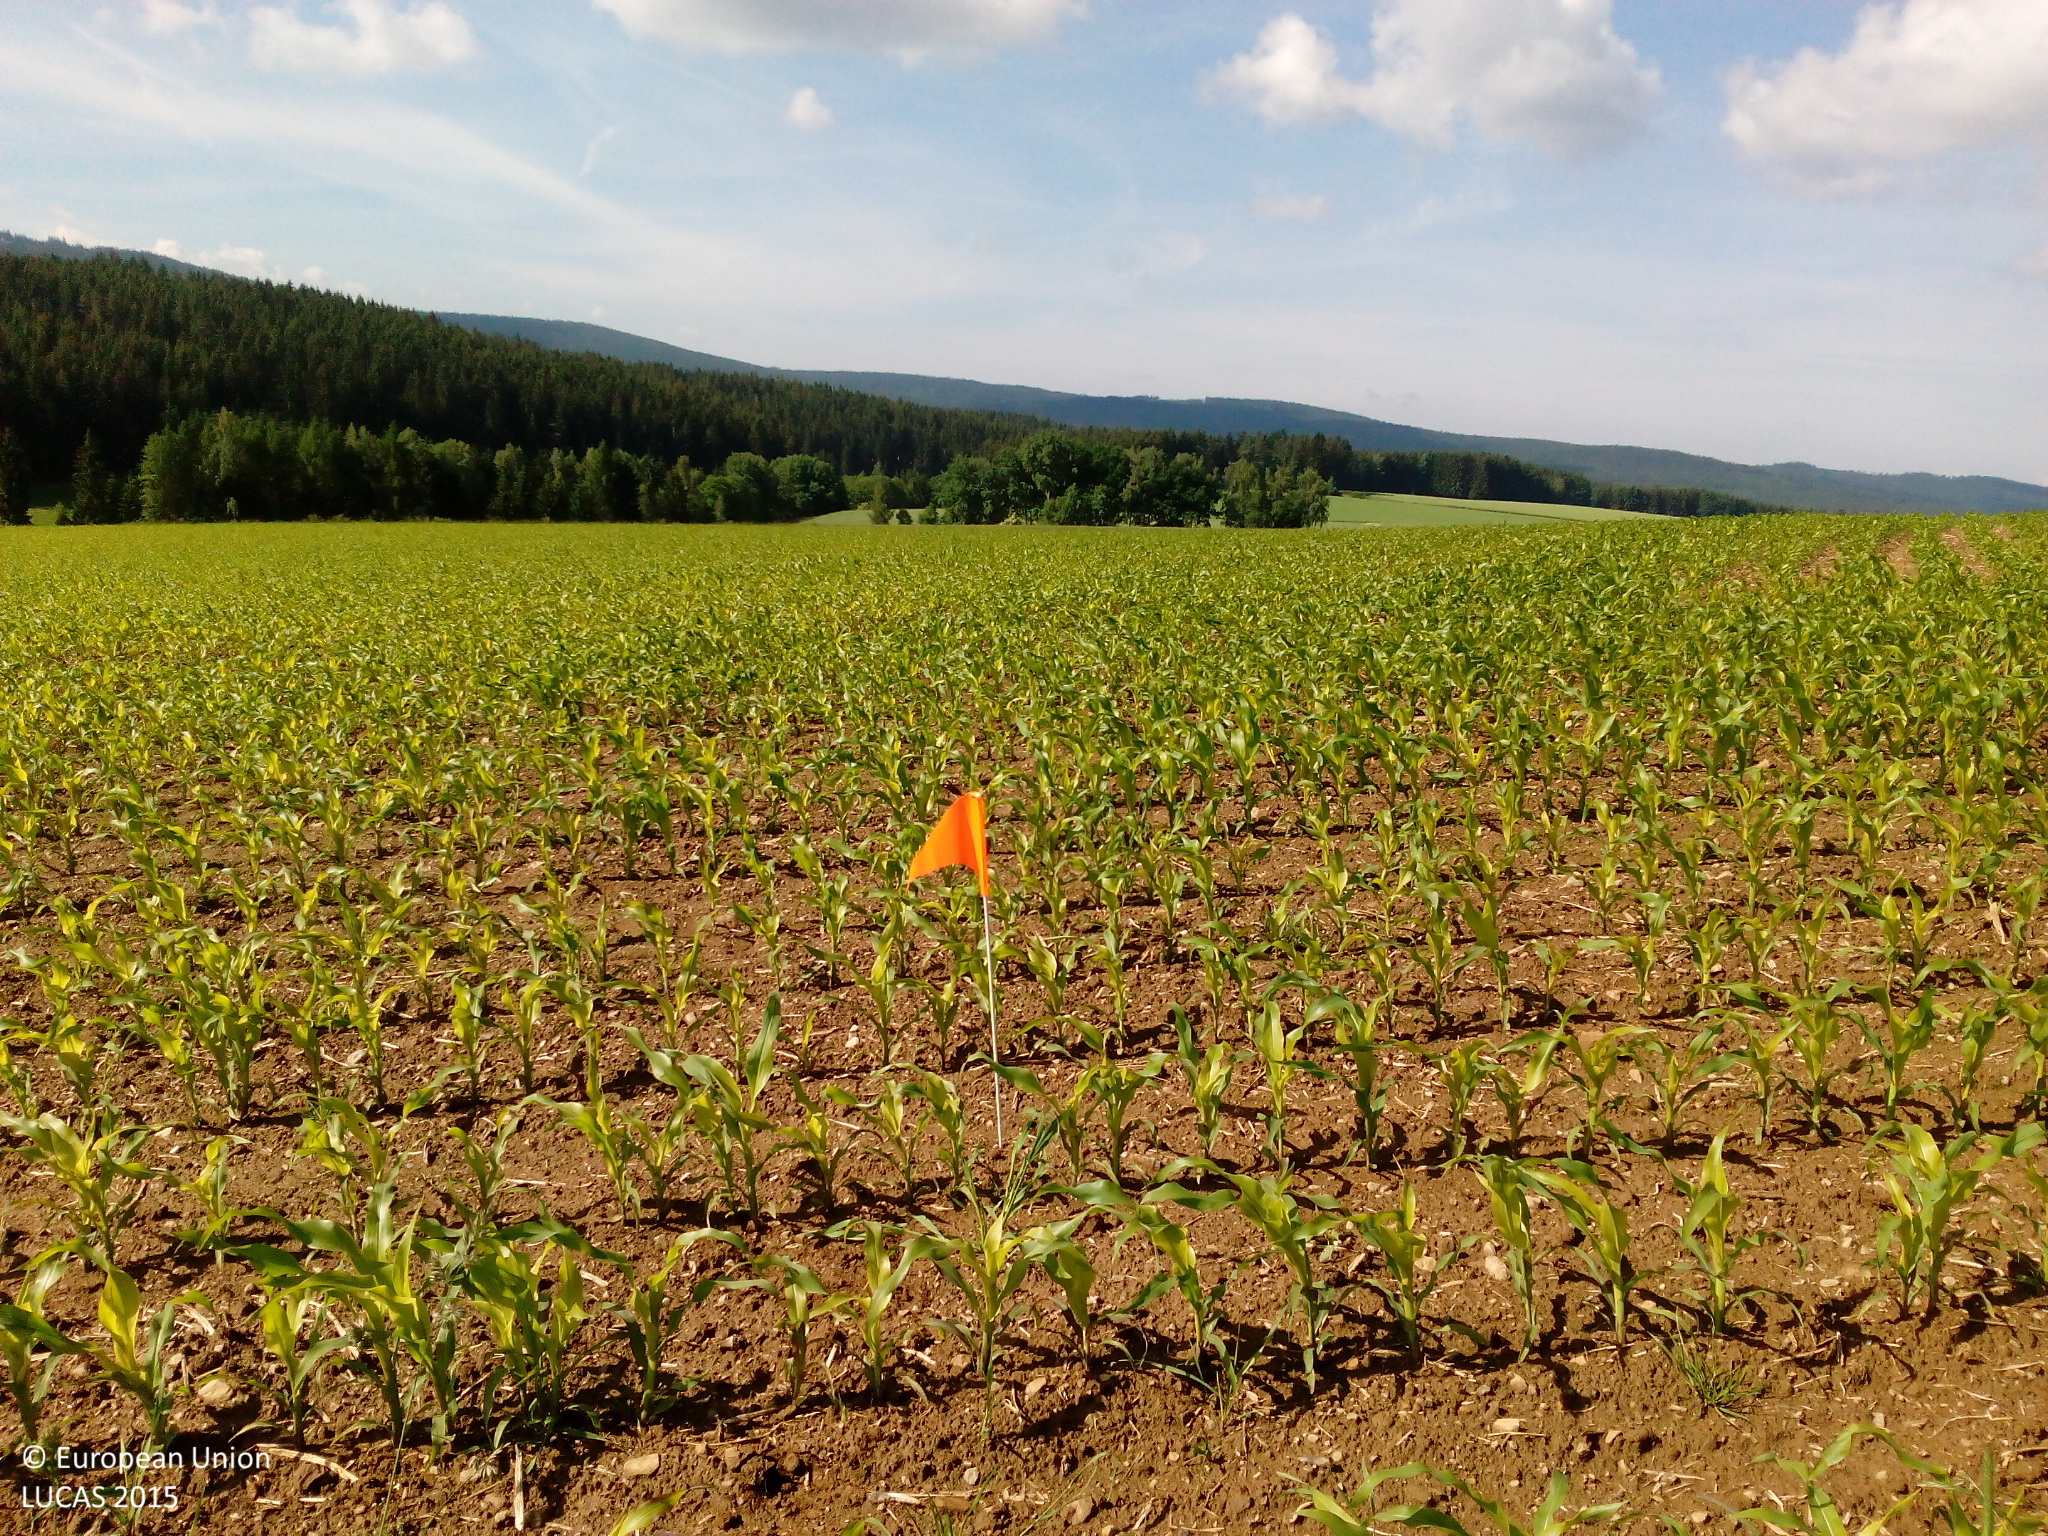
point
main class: Cropland
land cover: Maize
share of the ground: 25 - 50 %
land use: Agriculture (excluding fallow land and kitchen gardens)
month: June
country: DE
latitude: 49.9776
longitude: 12.4679
